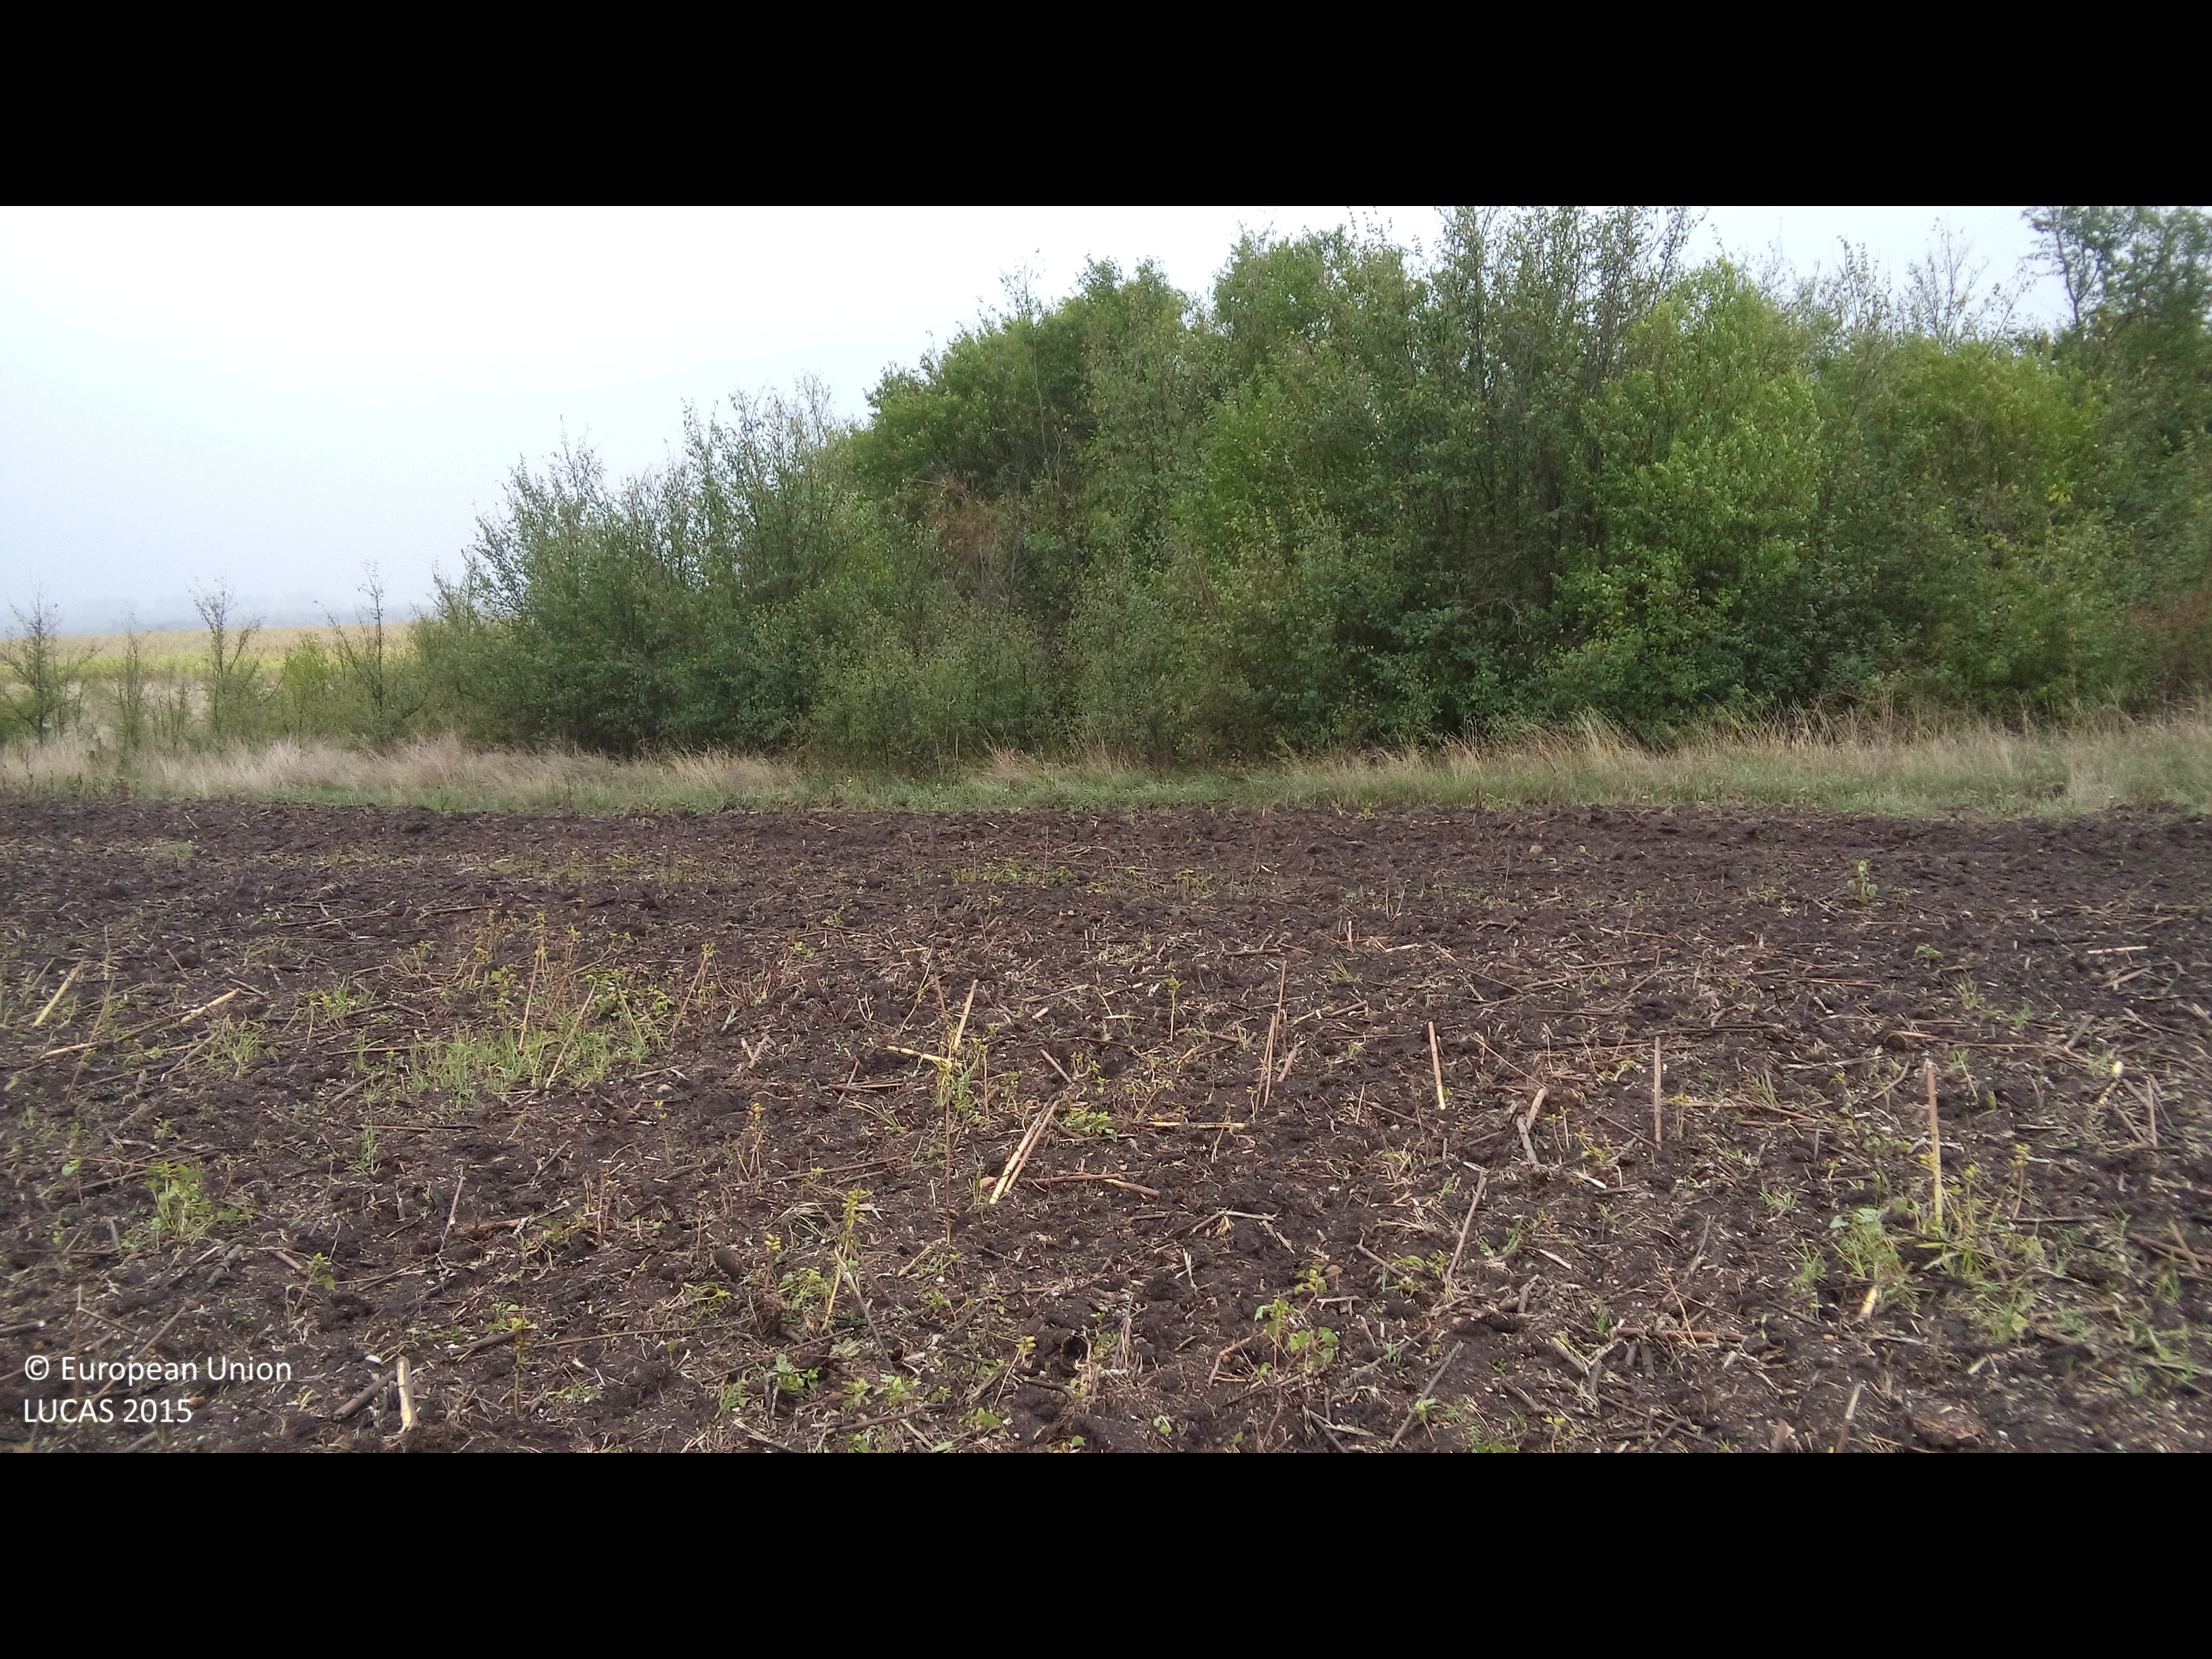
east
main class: Cropland
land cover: Sunflower
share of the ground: 10 - 25 %
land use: Agriculture (excluding fallow land and kitchen gardens)
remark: Harvested field
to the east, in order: Sunflower
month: September
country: BG
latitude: 42.7376
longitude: 23.1882
